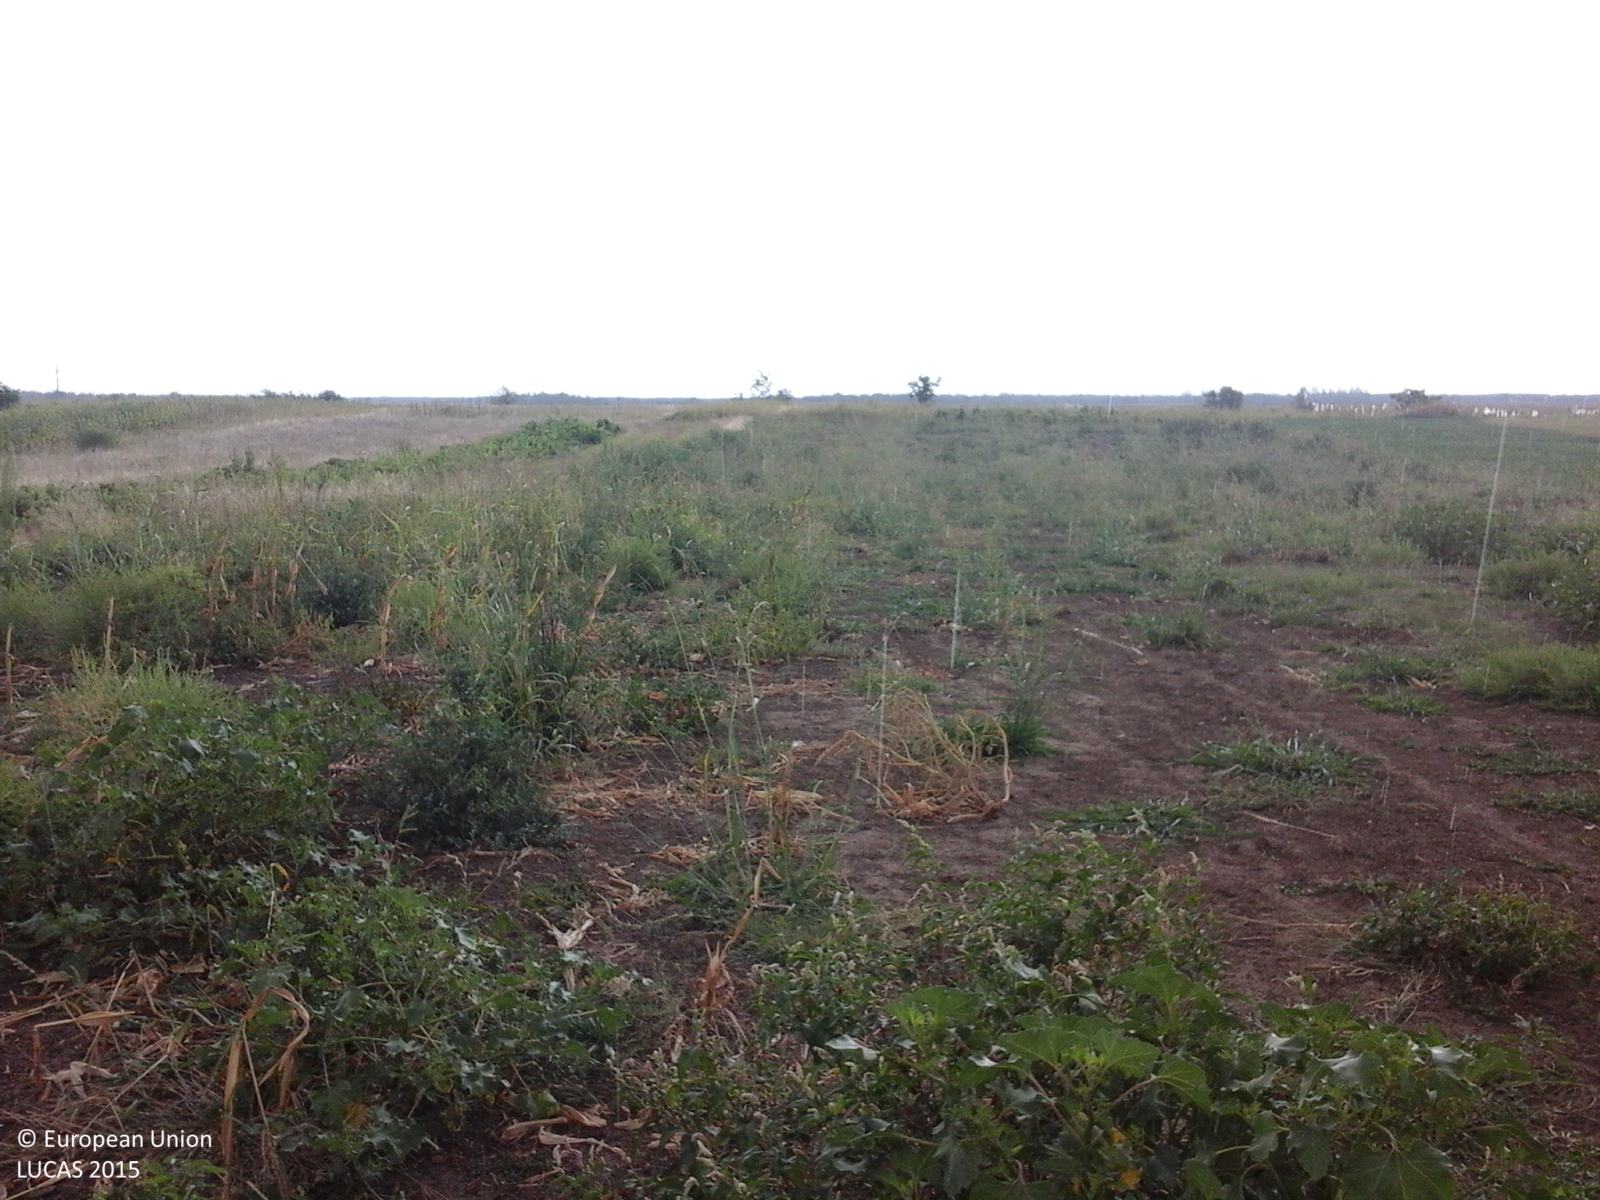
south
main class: Grassland
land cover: Spontaneously vegetated surfaces
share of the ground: 50 - 75 %
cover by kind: herbaceous plants 75 %, consolidated bare surface 25 %
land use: Agriculture (excluding fallow land and kitchen gardens)
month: August
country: RO
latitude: 43.9054
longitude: 23.0528
